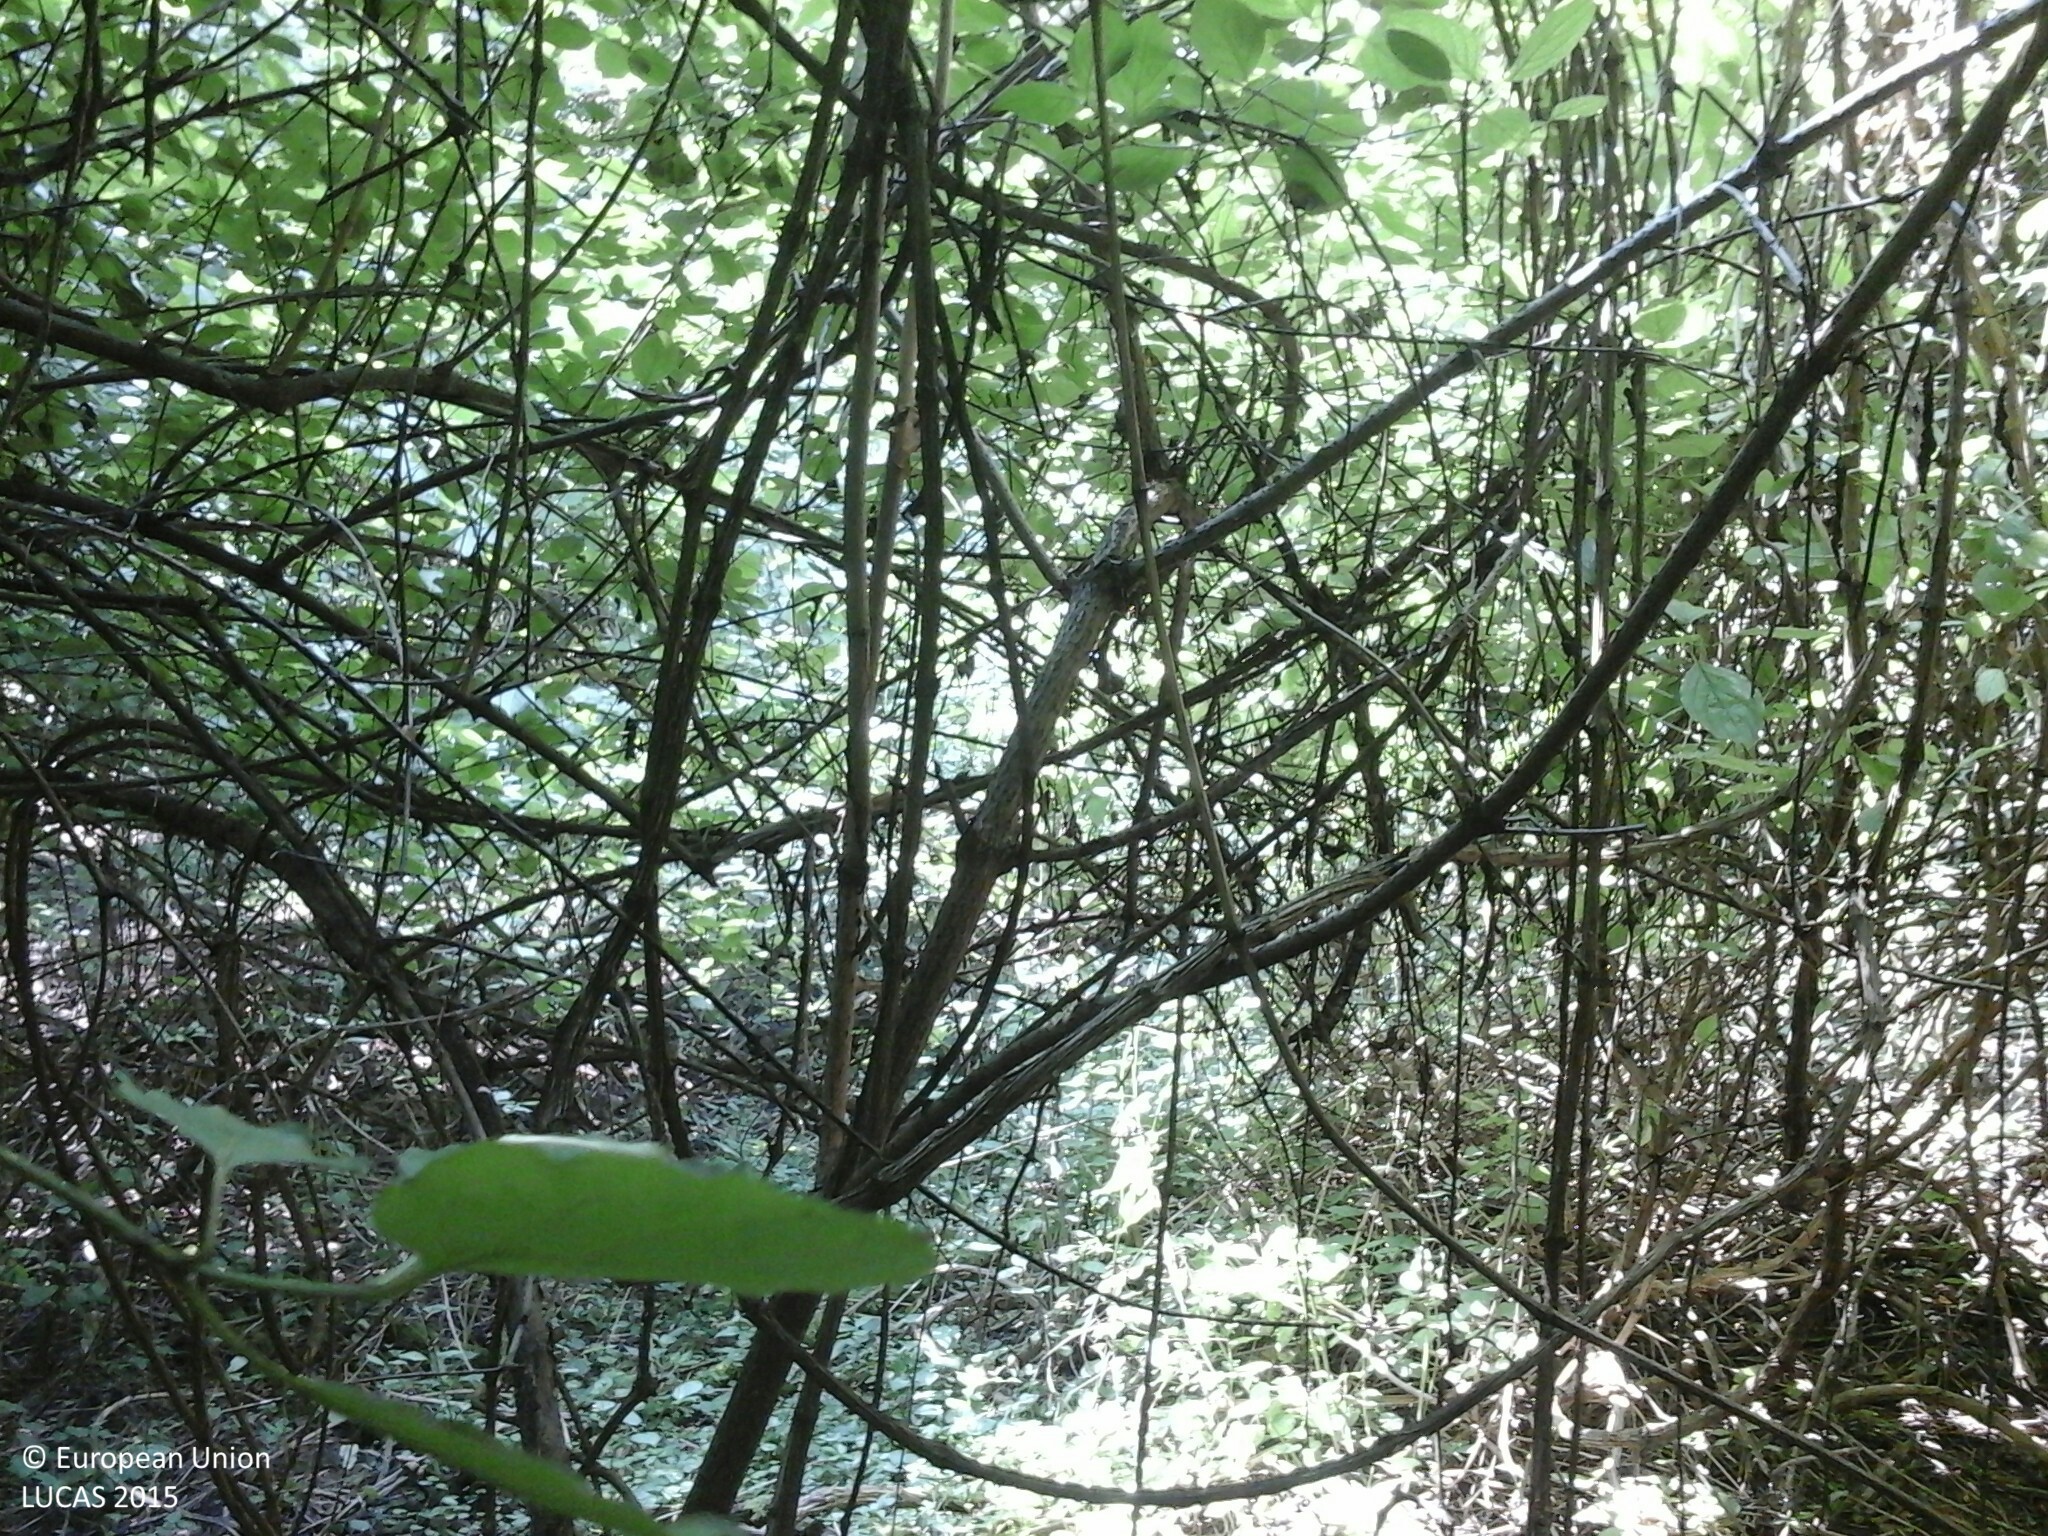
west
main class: Woodland
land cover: Broadleaved woodland
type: acidophilous oak and oak-birch forest
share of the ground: > 75 %
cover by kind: broadleaved forest trees 90 %, shrubs 10 %
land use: Forestry
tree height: > 5 m
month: August
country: HU
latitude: 48.1302
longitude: 20.3919
